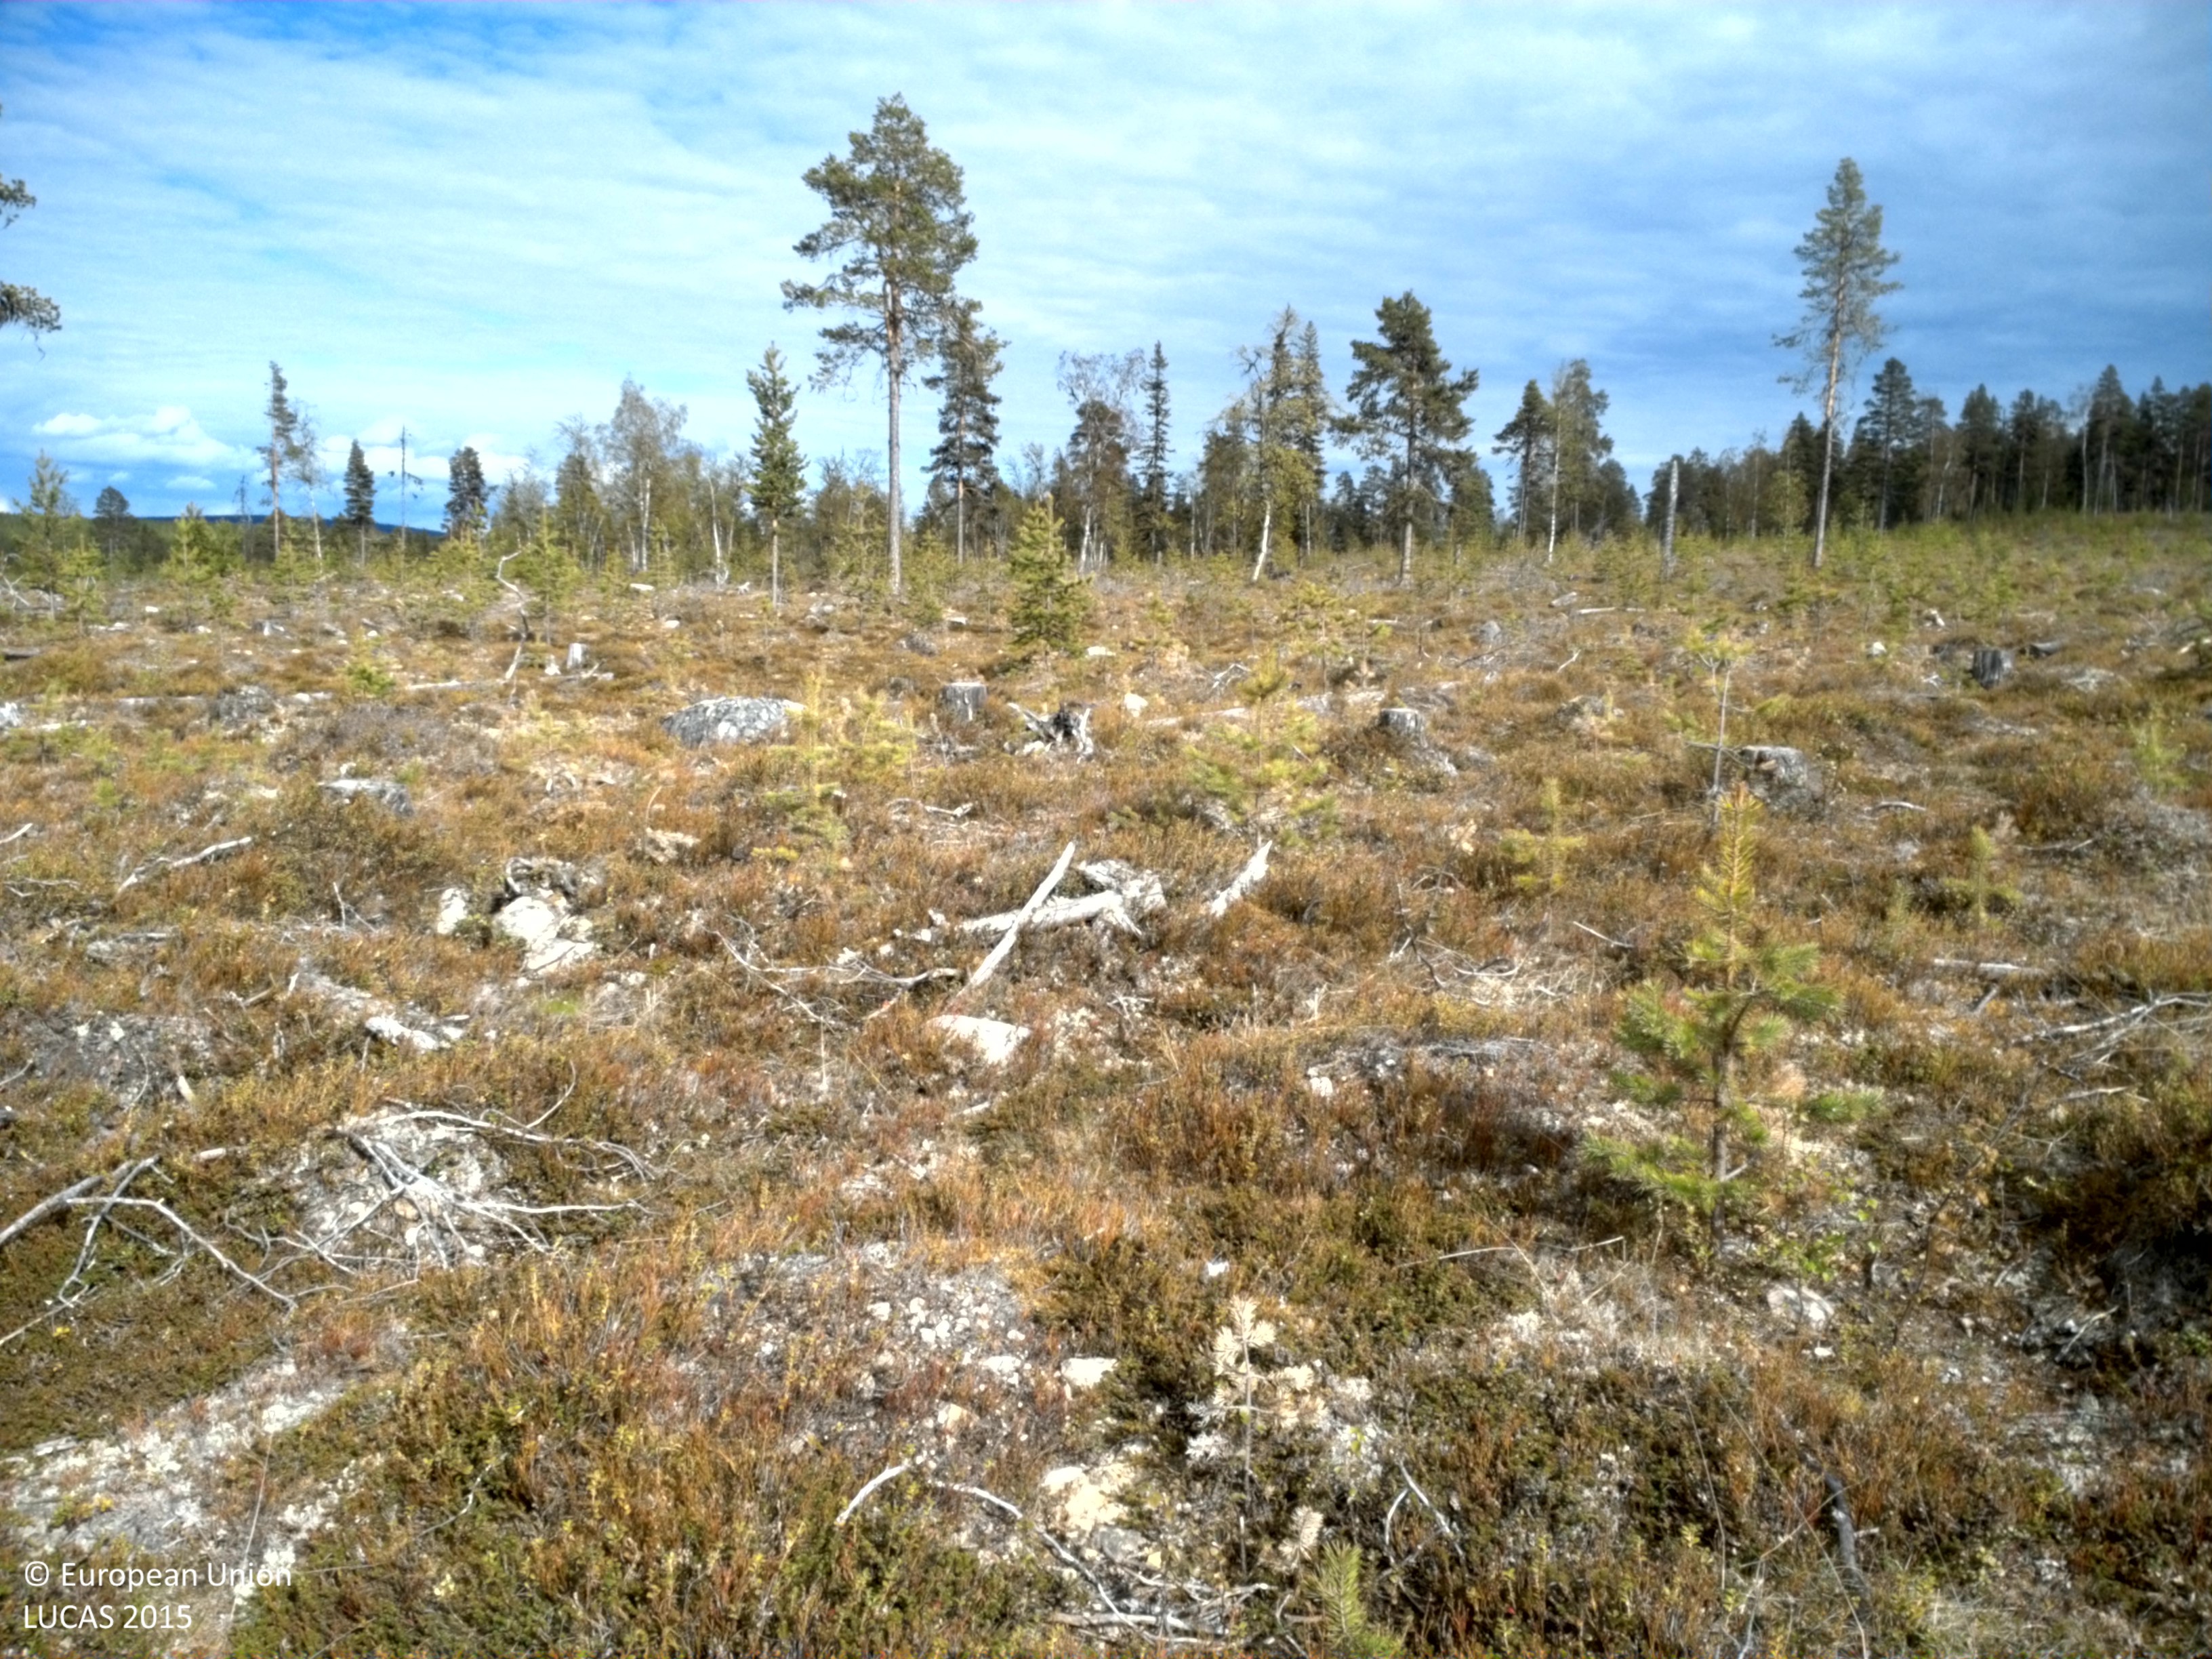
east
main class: Shrubland
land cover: Shrubland with sparse tree cover
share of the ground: > 75 %
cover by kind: shrubs 90 %, coniferous forest trees 5 %, herbaceous plants 5 %
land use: Forestry
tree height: < 5 m
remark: Clear cut
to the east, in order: Shrubland with sparse tree cover; Pine dominated coniferous woodland; Broadleaved woodland; Pine dominated coniferous woodland; Broadleaved woodland
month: June
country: SE
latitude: 66.2122
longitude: 18.7745
